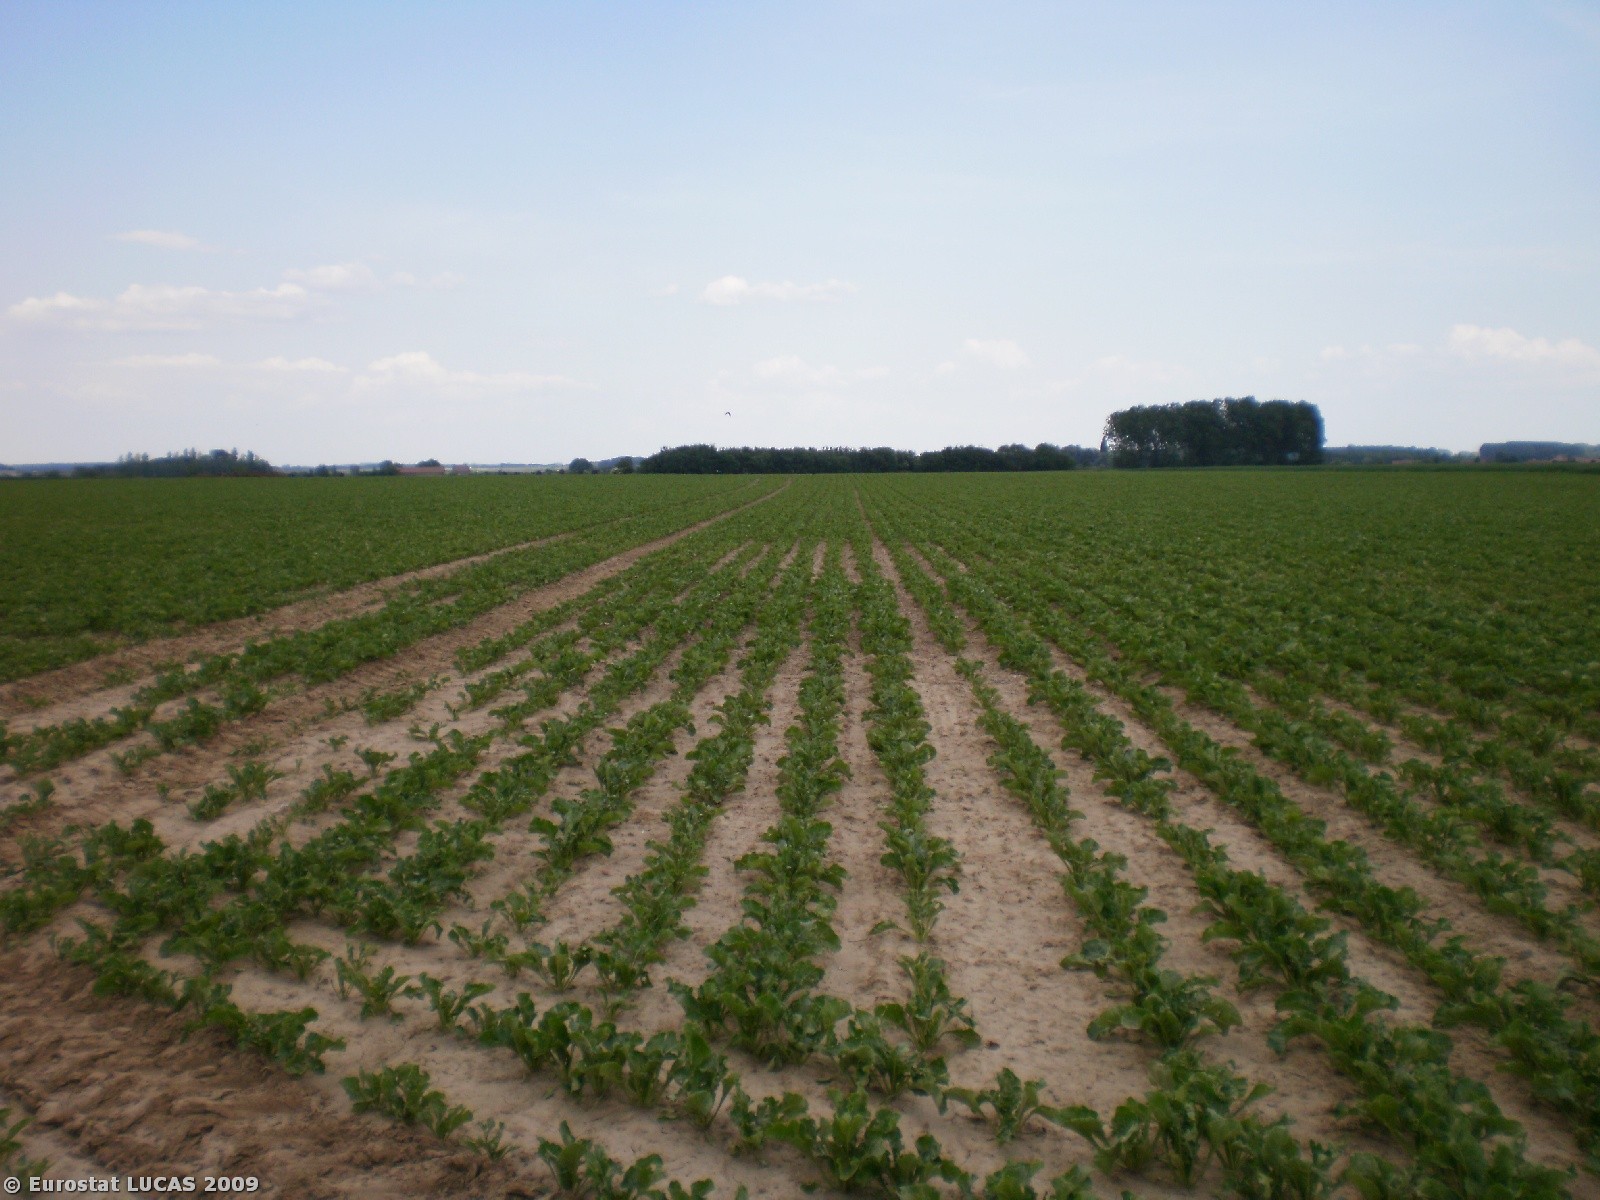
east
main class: Cropland
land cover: Sugar beet
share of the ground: 50 - 75 %
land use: Agriculture (excluding fallow land and kitchen gardens)
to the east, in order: Sugar beet
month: June
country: BE
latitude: 50.5743
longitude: 3.7945
